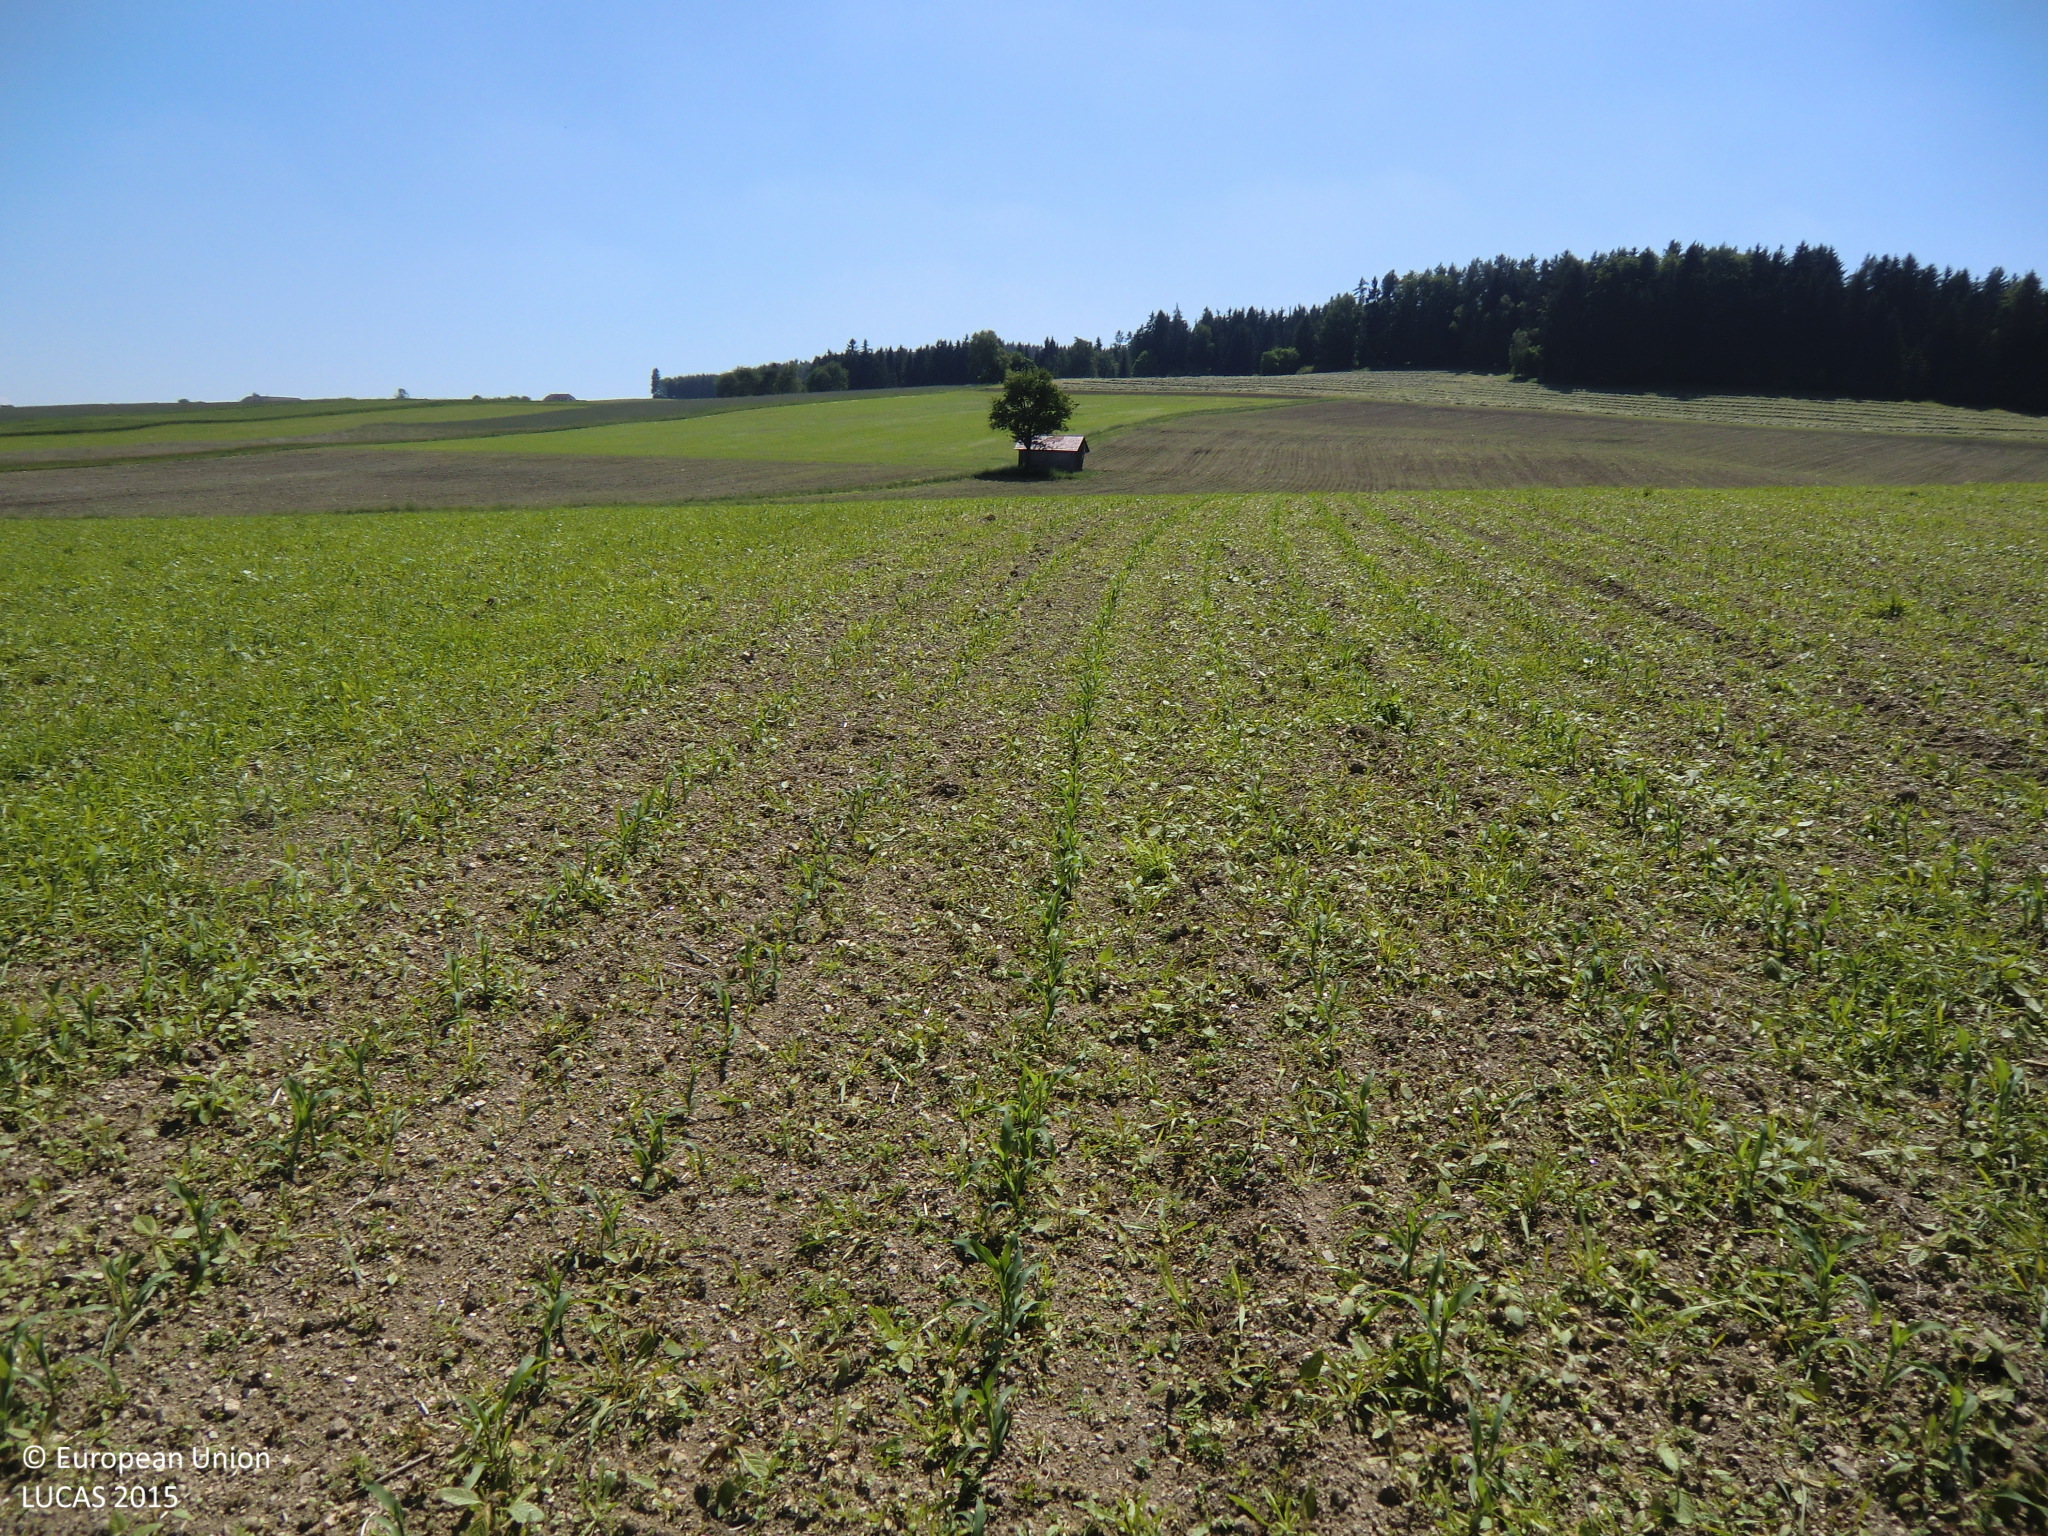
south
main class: Cropland
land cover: Maize
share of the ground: 25 - 50 %
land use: Agriculture (excluding fallow land and kitchen gardens)
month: June
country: AT
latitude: 48.5490
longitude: 14.4304
